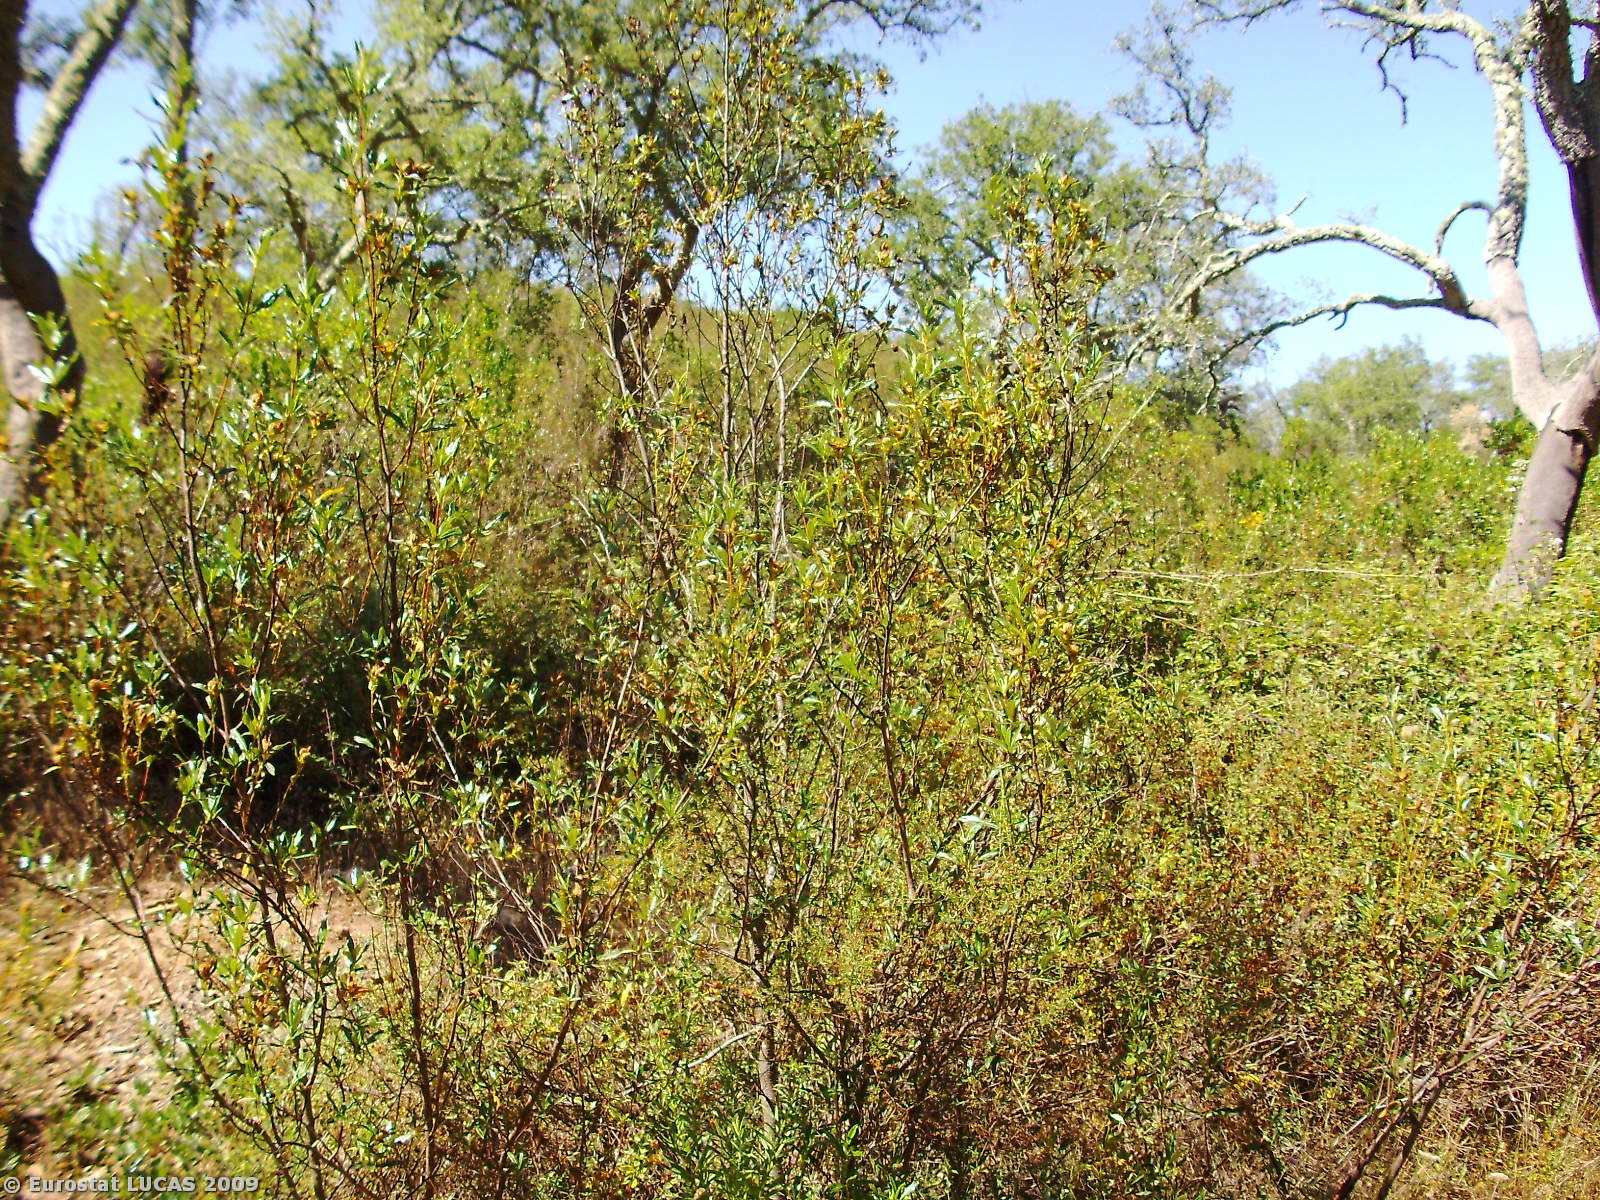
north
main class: Shrubland
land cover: Shrubland with sparse tree cover
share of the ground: > 75 %
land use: Unused
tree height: > 5 m
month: July
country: PT
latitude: 37.6439
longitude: -8.4742
